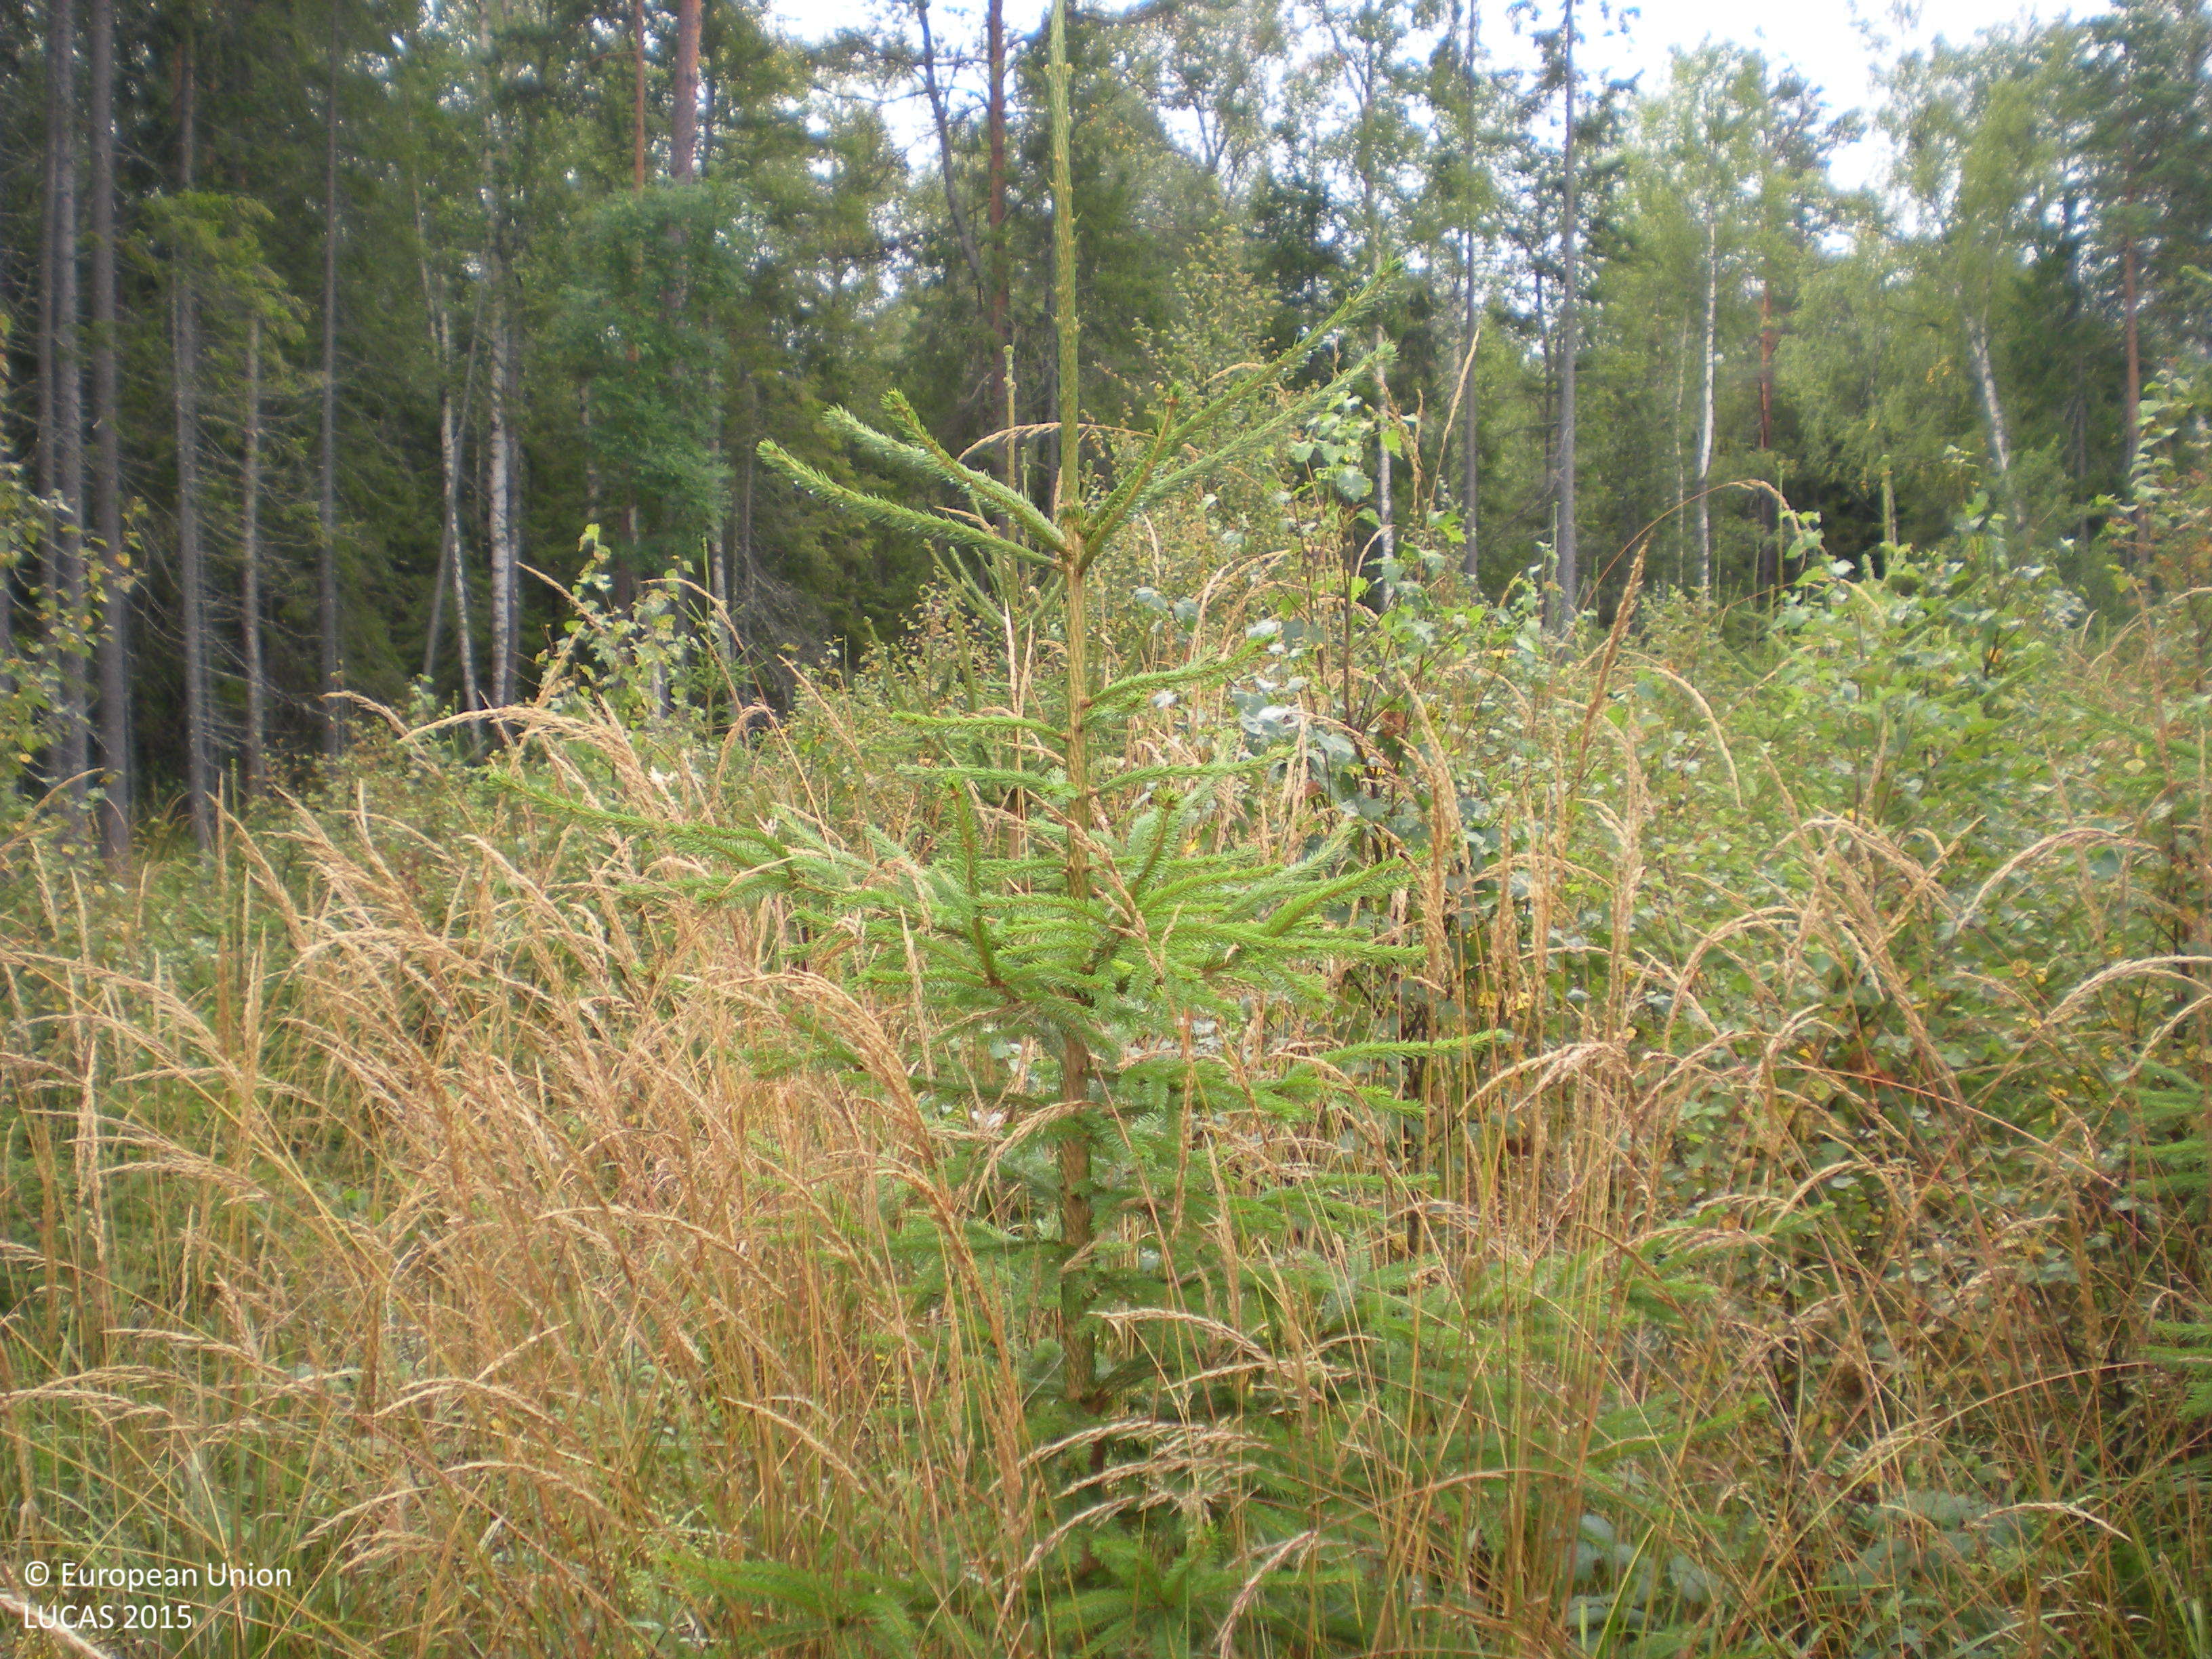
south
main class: Woodland
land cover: Spruce dominated mixed woodland
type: boreal forest
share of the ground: 50 - 75 %
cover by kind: broadleaved forest trees 35 %, coniferous forest trees 30 %, herbaceous plants 25 %, shrubs 5 %, lichens and mosses 5 %
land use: Forestry
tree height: < 5 m
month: August
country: SE
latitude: 60.4807
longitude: 17.2864
